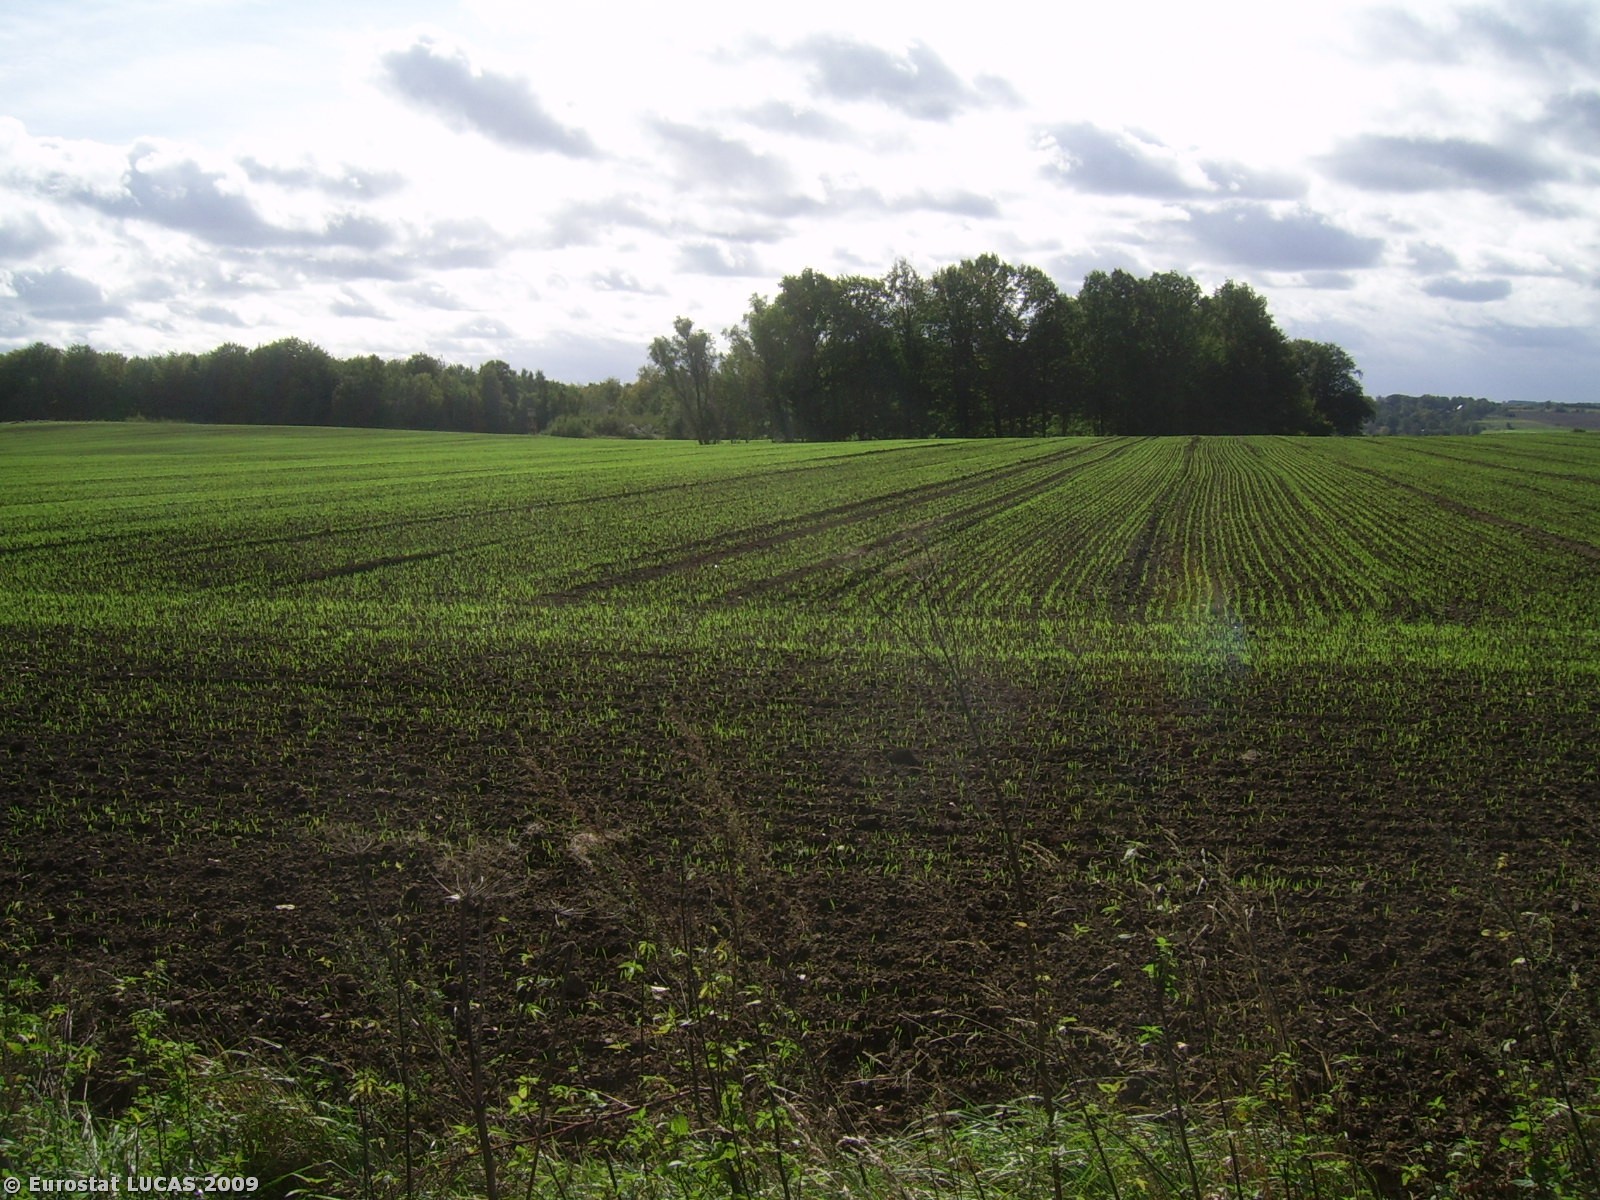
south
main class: Cropland
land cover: Common wheat
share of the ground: < 10 %
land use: Agriculture (excluding fallow land and kitchen gardens)
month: September
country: PL
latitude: 54.3123
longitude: 16.4461
